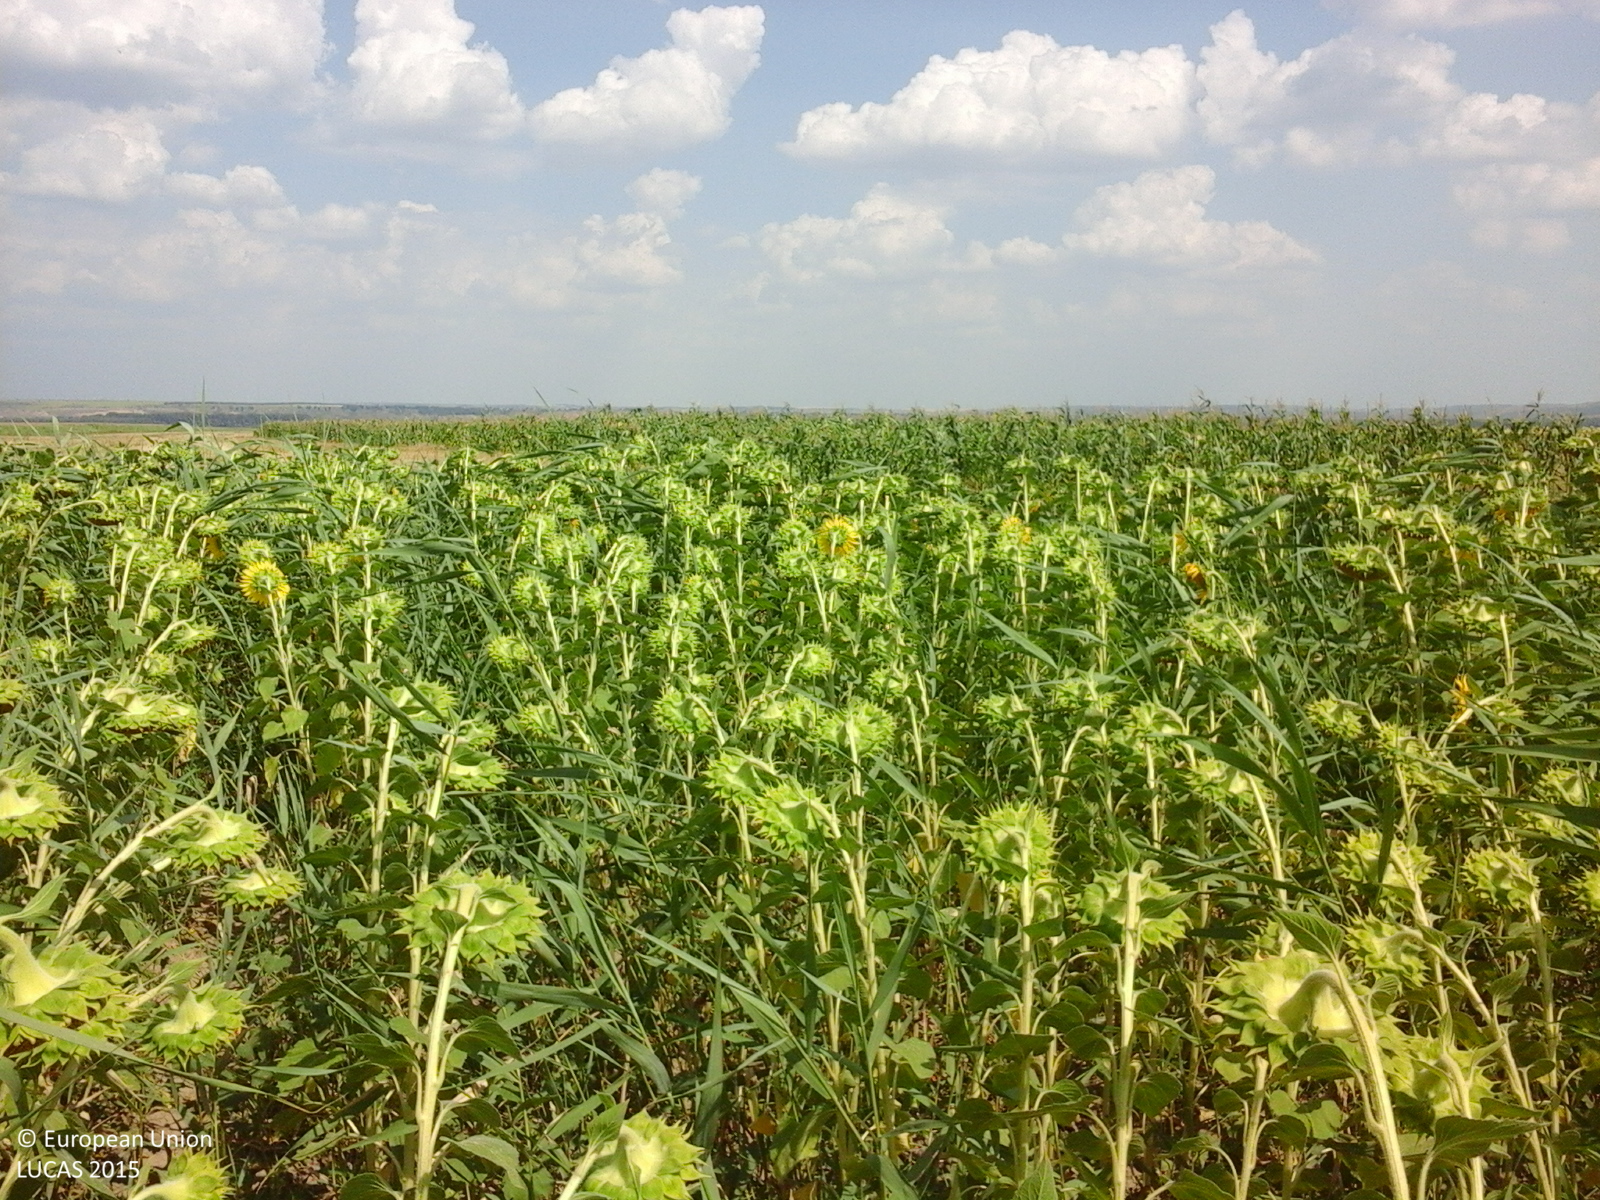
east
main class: Cropland
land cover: Sunflower
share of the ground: > 75 %
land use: Agriculture (excluding fallow land and kitchen gardens)
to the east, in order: Sunflower; Tracks; Grass margins; Ditches and canals; Grass margins; Tracks; Maize; Common wheat; Sunflower; Spontaneously vegetated surfaces; Common wheat
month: July
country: RO
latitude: 46.6183
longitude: 28.1938
